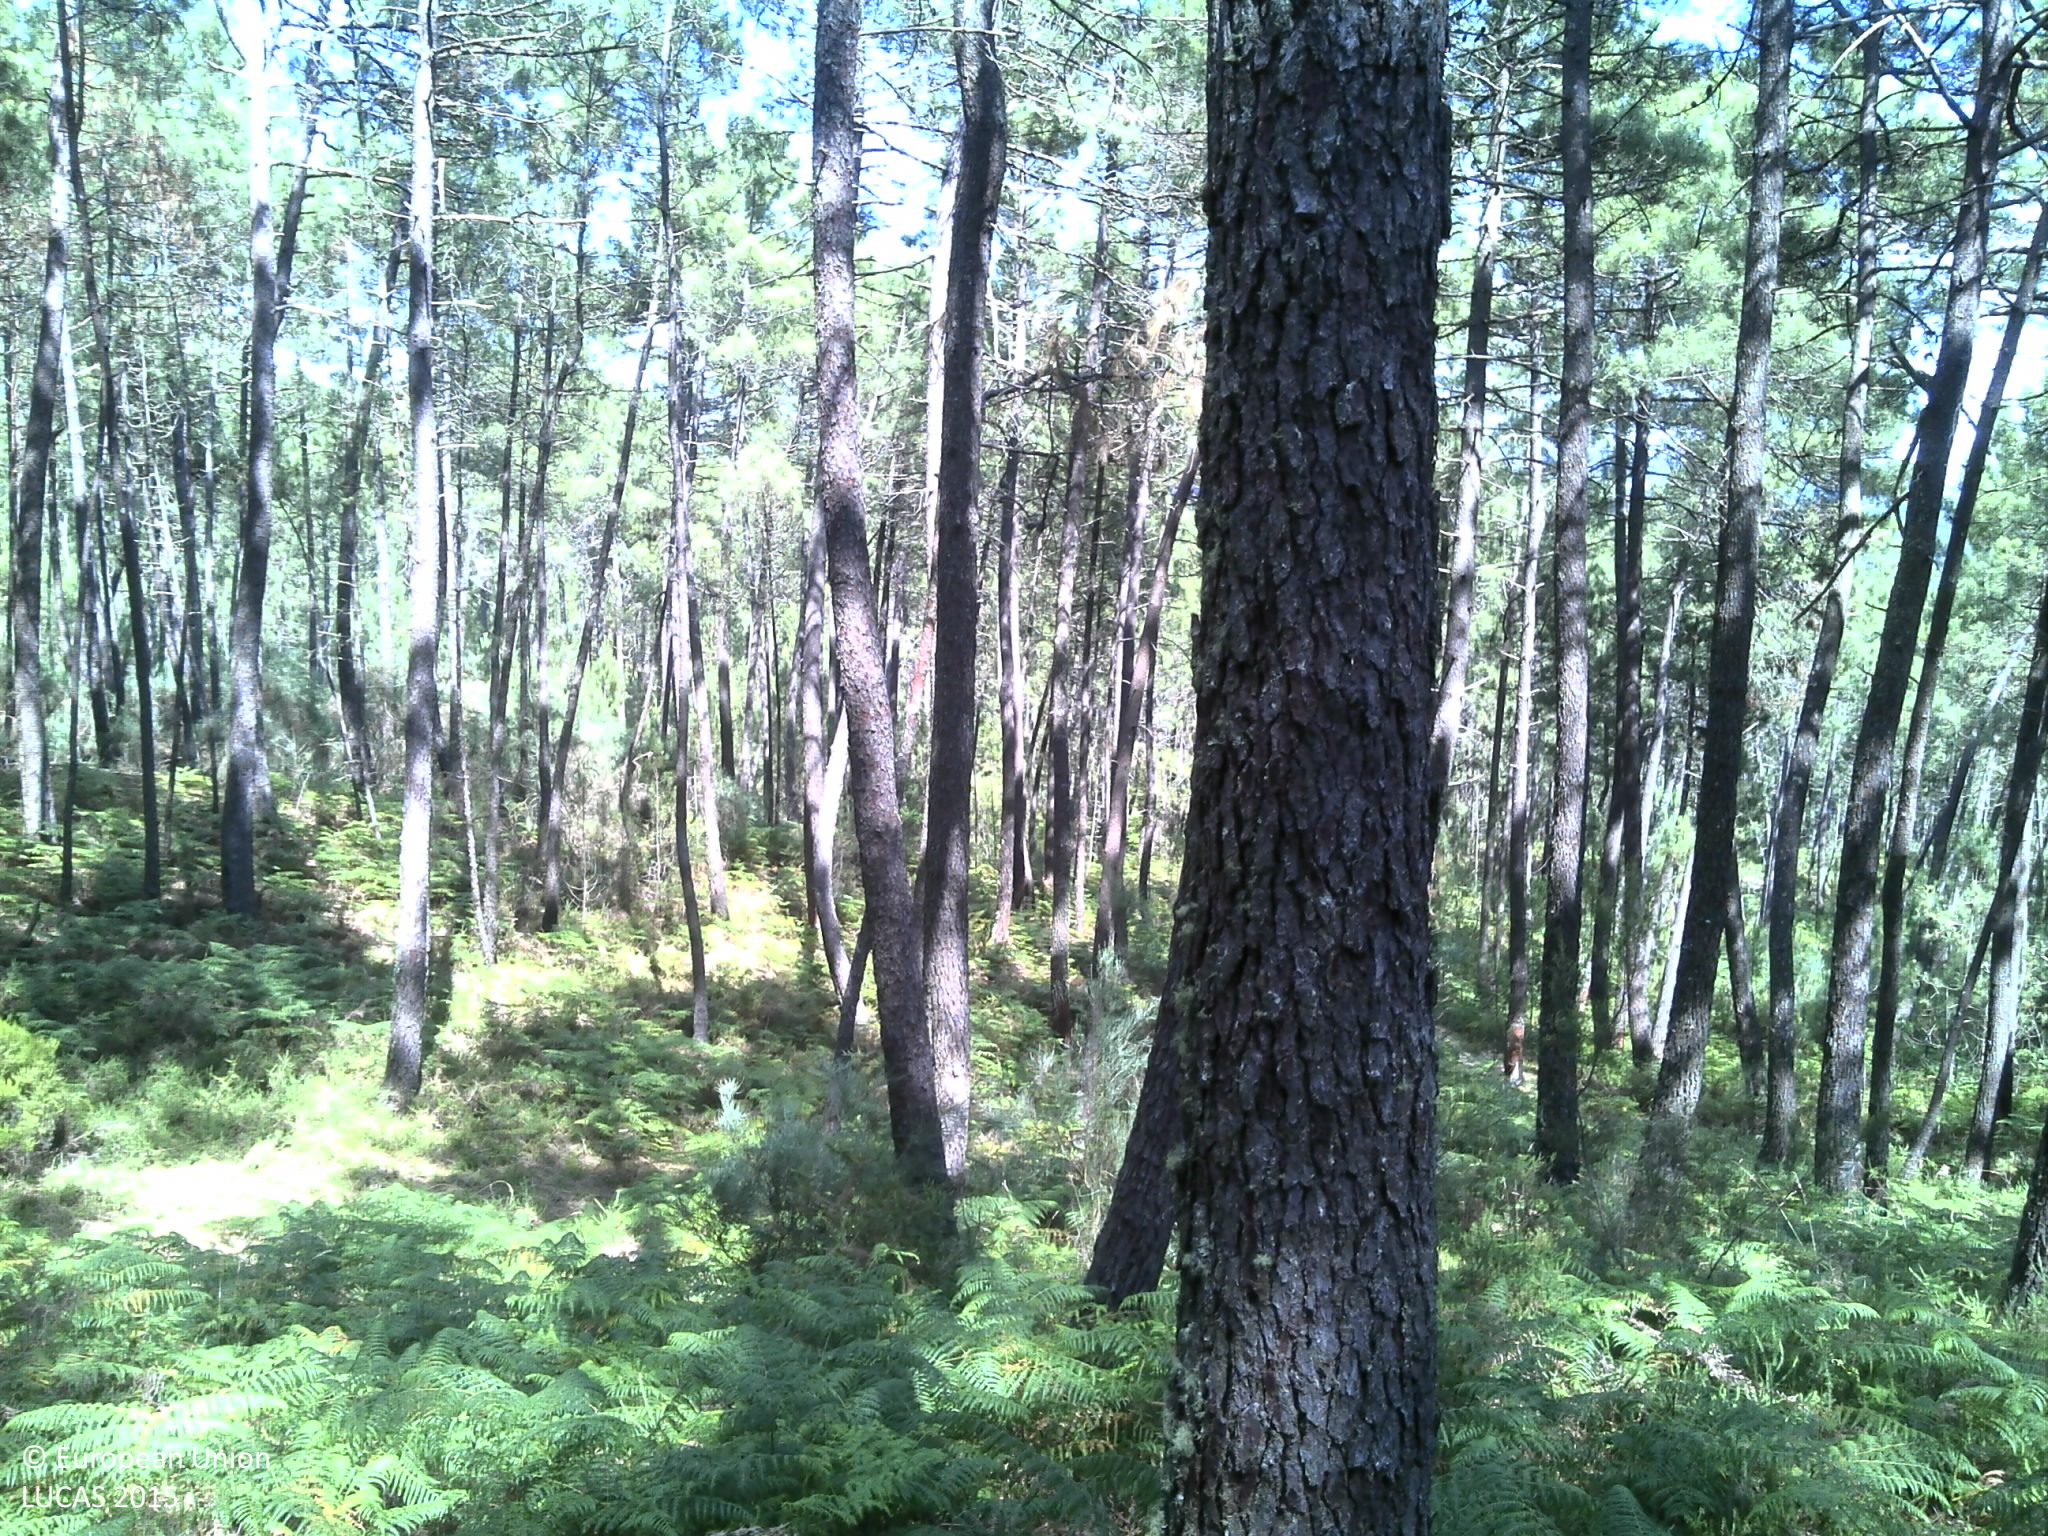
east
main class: Woodland
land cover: Pine dominated coniferous woodland
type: coniferous forest of the mediterranean region
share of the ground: 50 - 75 %
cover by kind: coniferous forest trees 60 %, shrubs 25 %, unconsolidated bare surface 15 %
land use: Forestry
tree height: > 5 m
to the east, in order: Pine dominated coniferous woodland; Tracks; Pine dominated coniferous woodland; Tracks; Pine dominated coniferous woodland
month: June
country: PT
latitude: 40.8404
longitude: -8.0029
